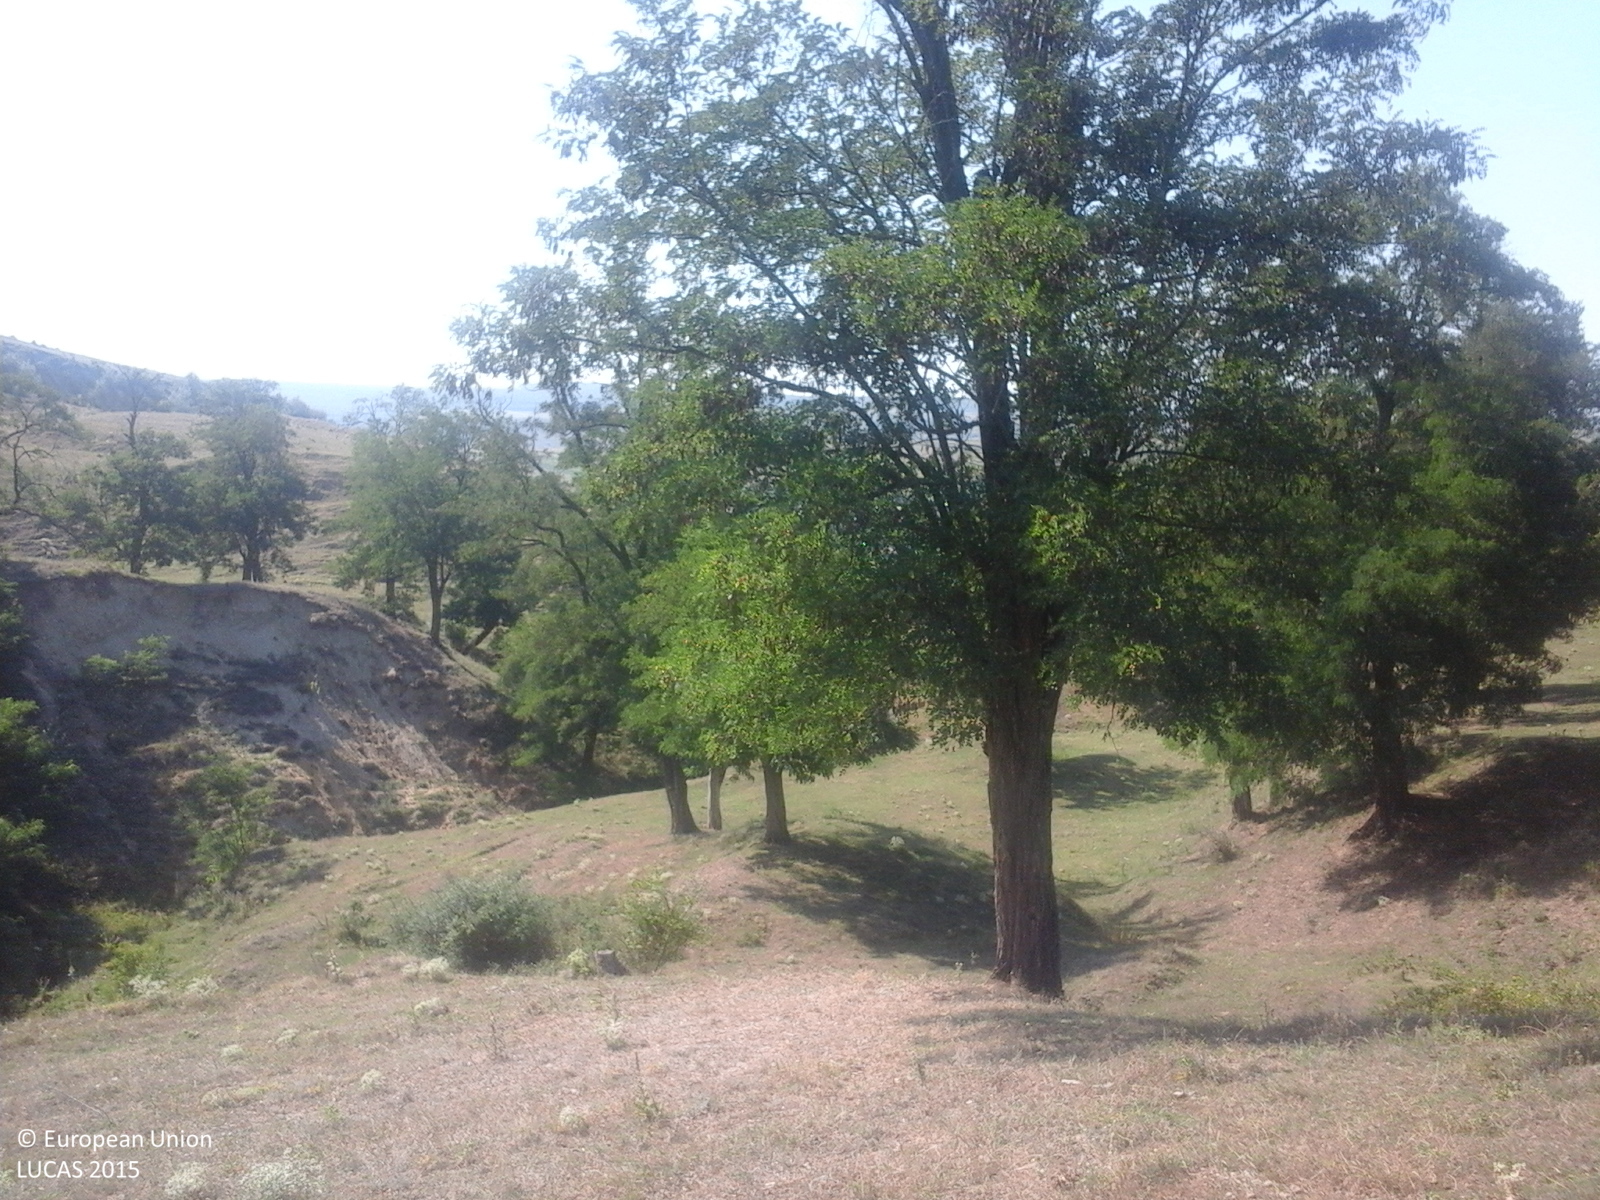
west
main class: Grassland
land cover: Grassland without tree/shrub cover
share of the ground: > 75 %
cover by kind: herbaceous plants 100 %
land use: Agriculture (excluding fallow land and kitchen gardens)
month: August
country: RO
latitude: 46.3519
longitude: 27.5906
